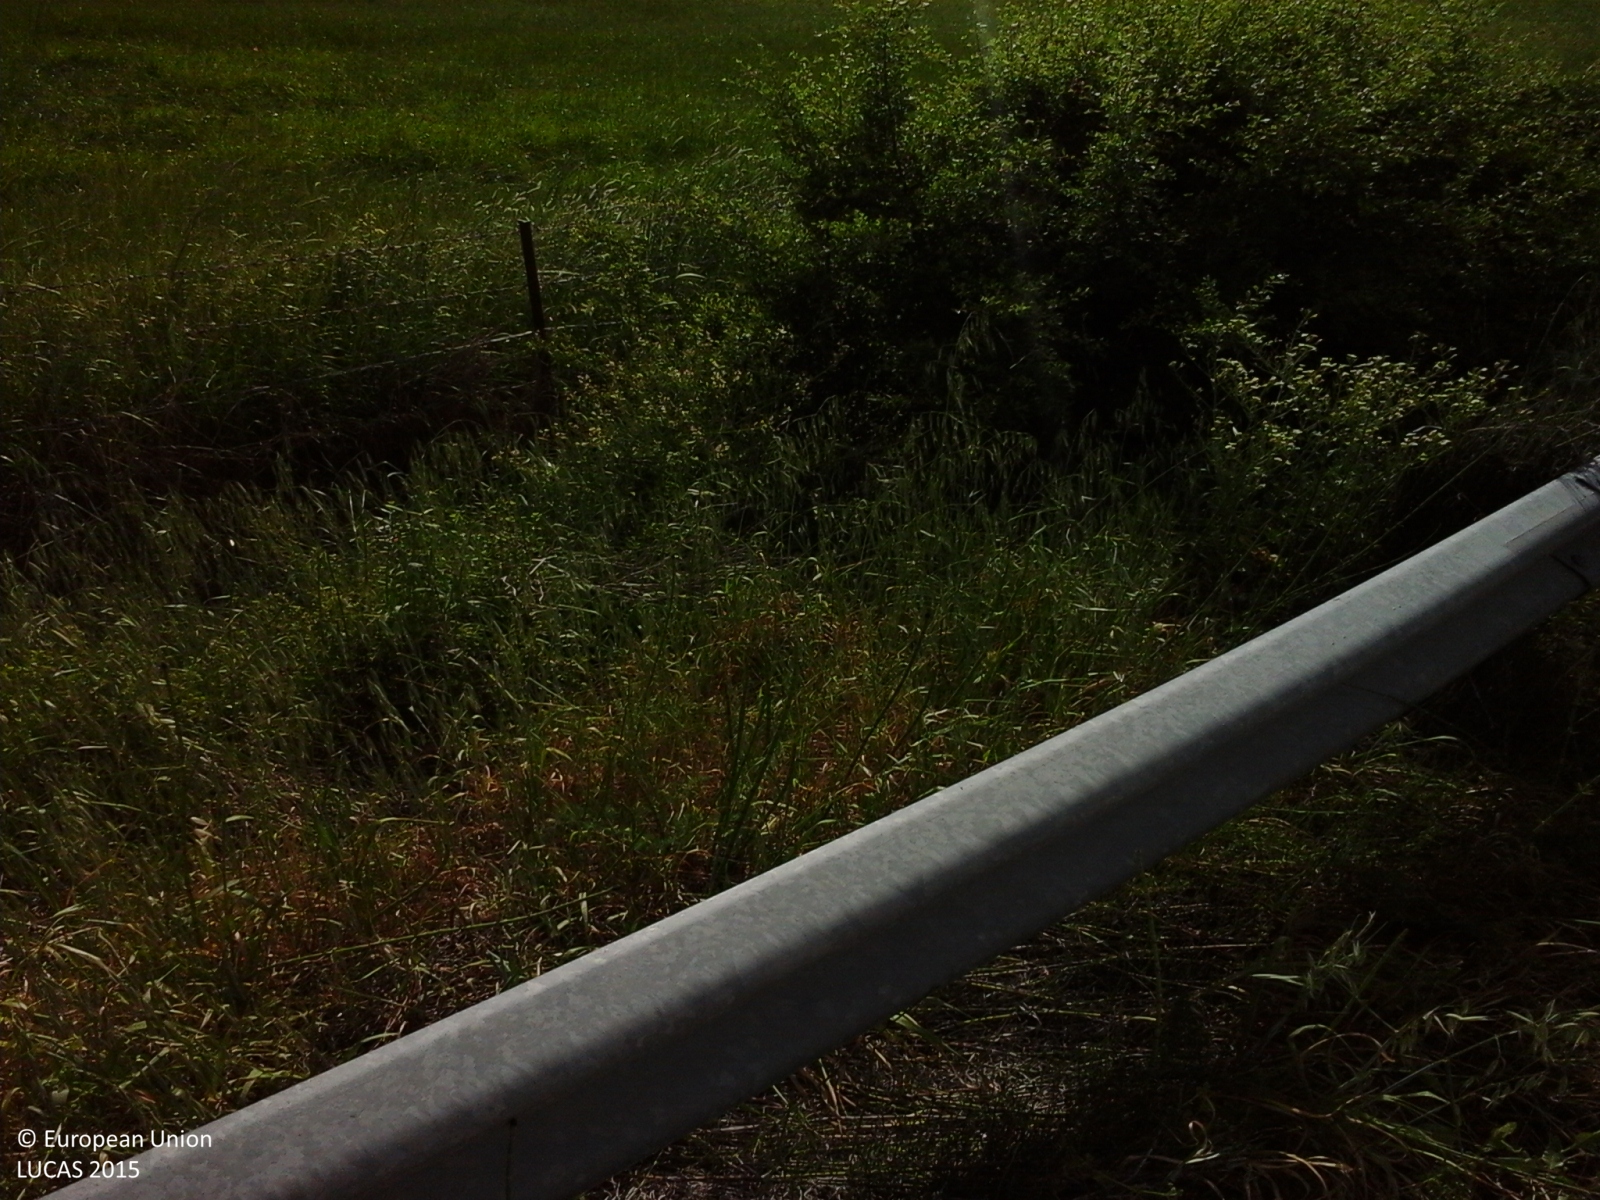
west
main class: Cropland
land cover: Mixed cereals for fodder
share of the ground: > 75 %
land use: Agriculture (excluding fallow land and kitchen gardens)
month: May
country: IT
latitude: 37.6452
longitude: 13.5437
